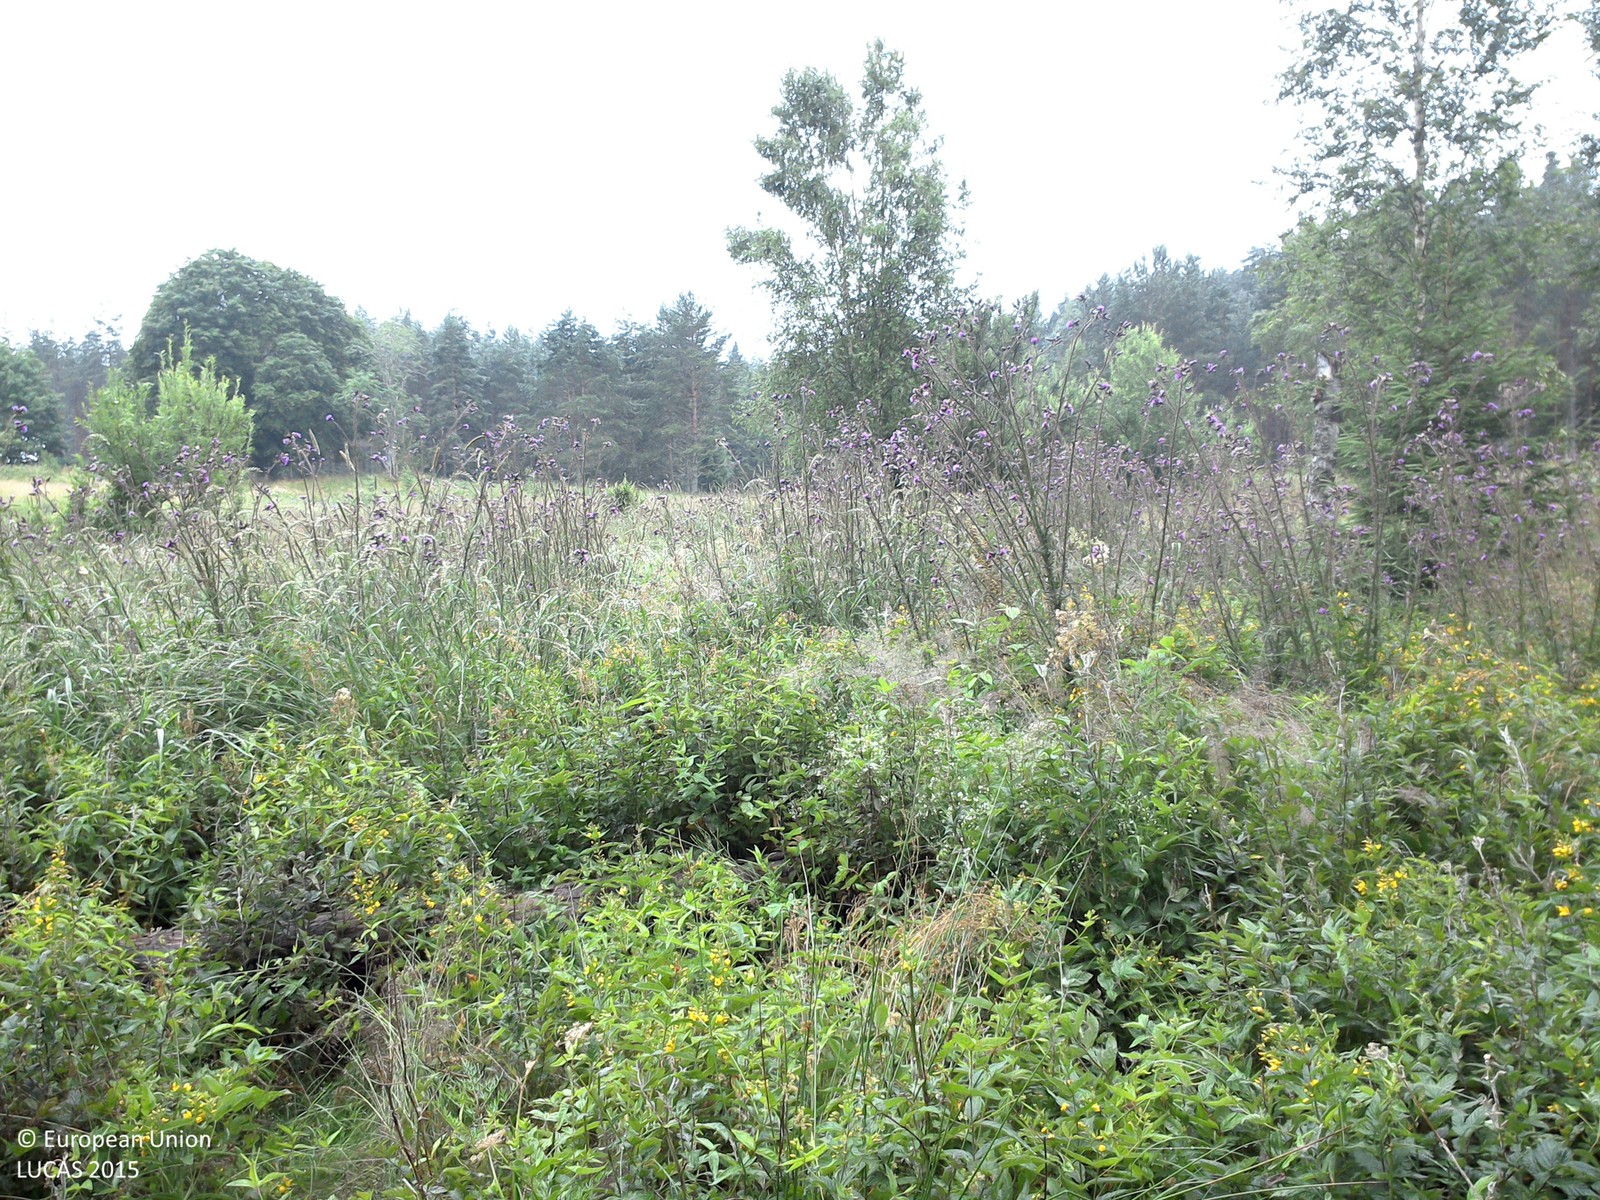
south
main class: Grassland
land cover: Grassland with sparse tree/shrub cover
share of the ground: > 75 %
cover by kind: herbaceous plants 95 %, broadleaved forest trees 5 %
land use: Agriculture (excluding fallow land and kitchen gardens)
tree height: > 5 m
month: July
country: SE
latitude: 57.7998
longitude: 15.9362
